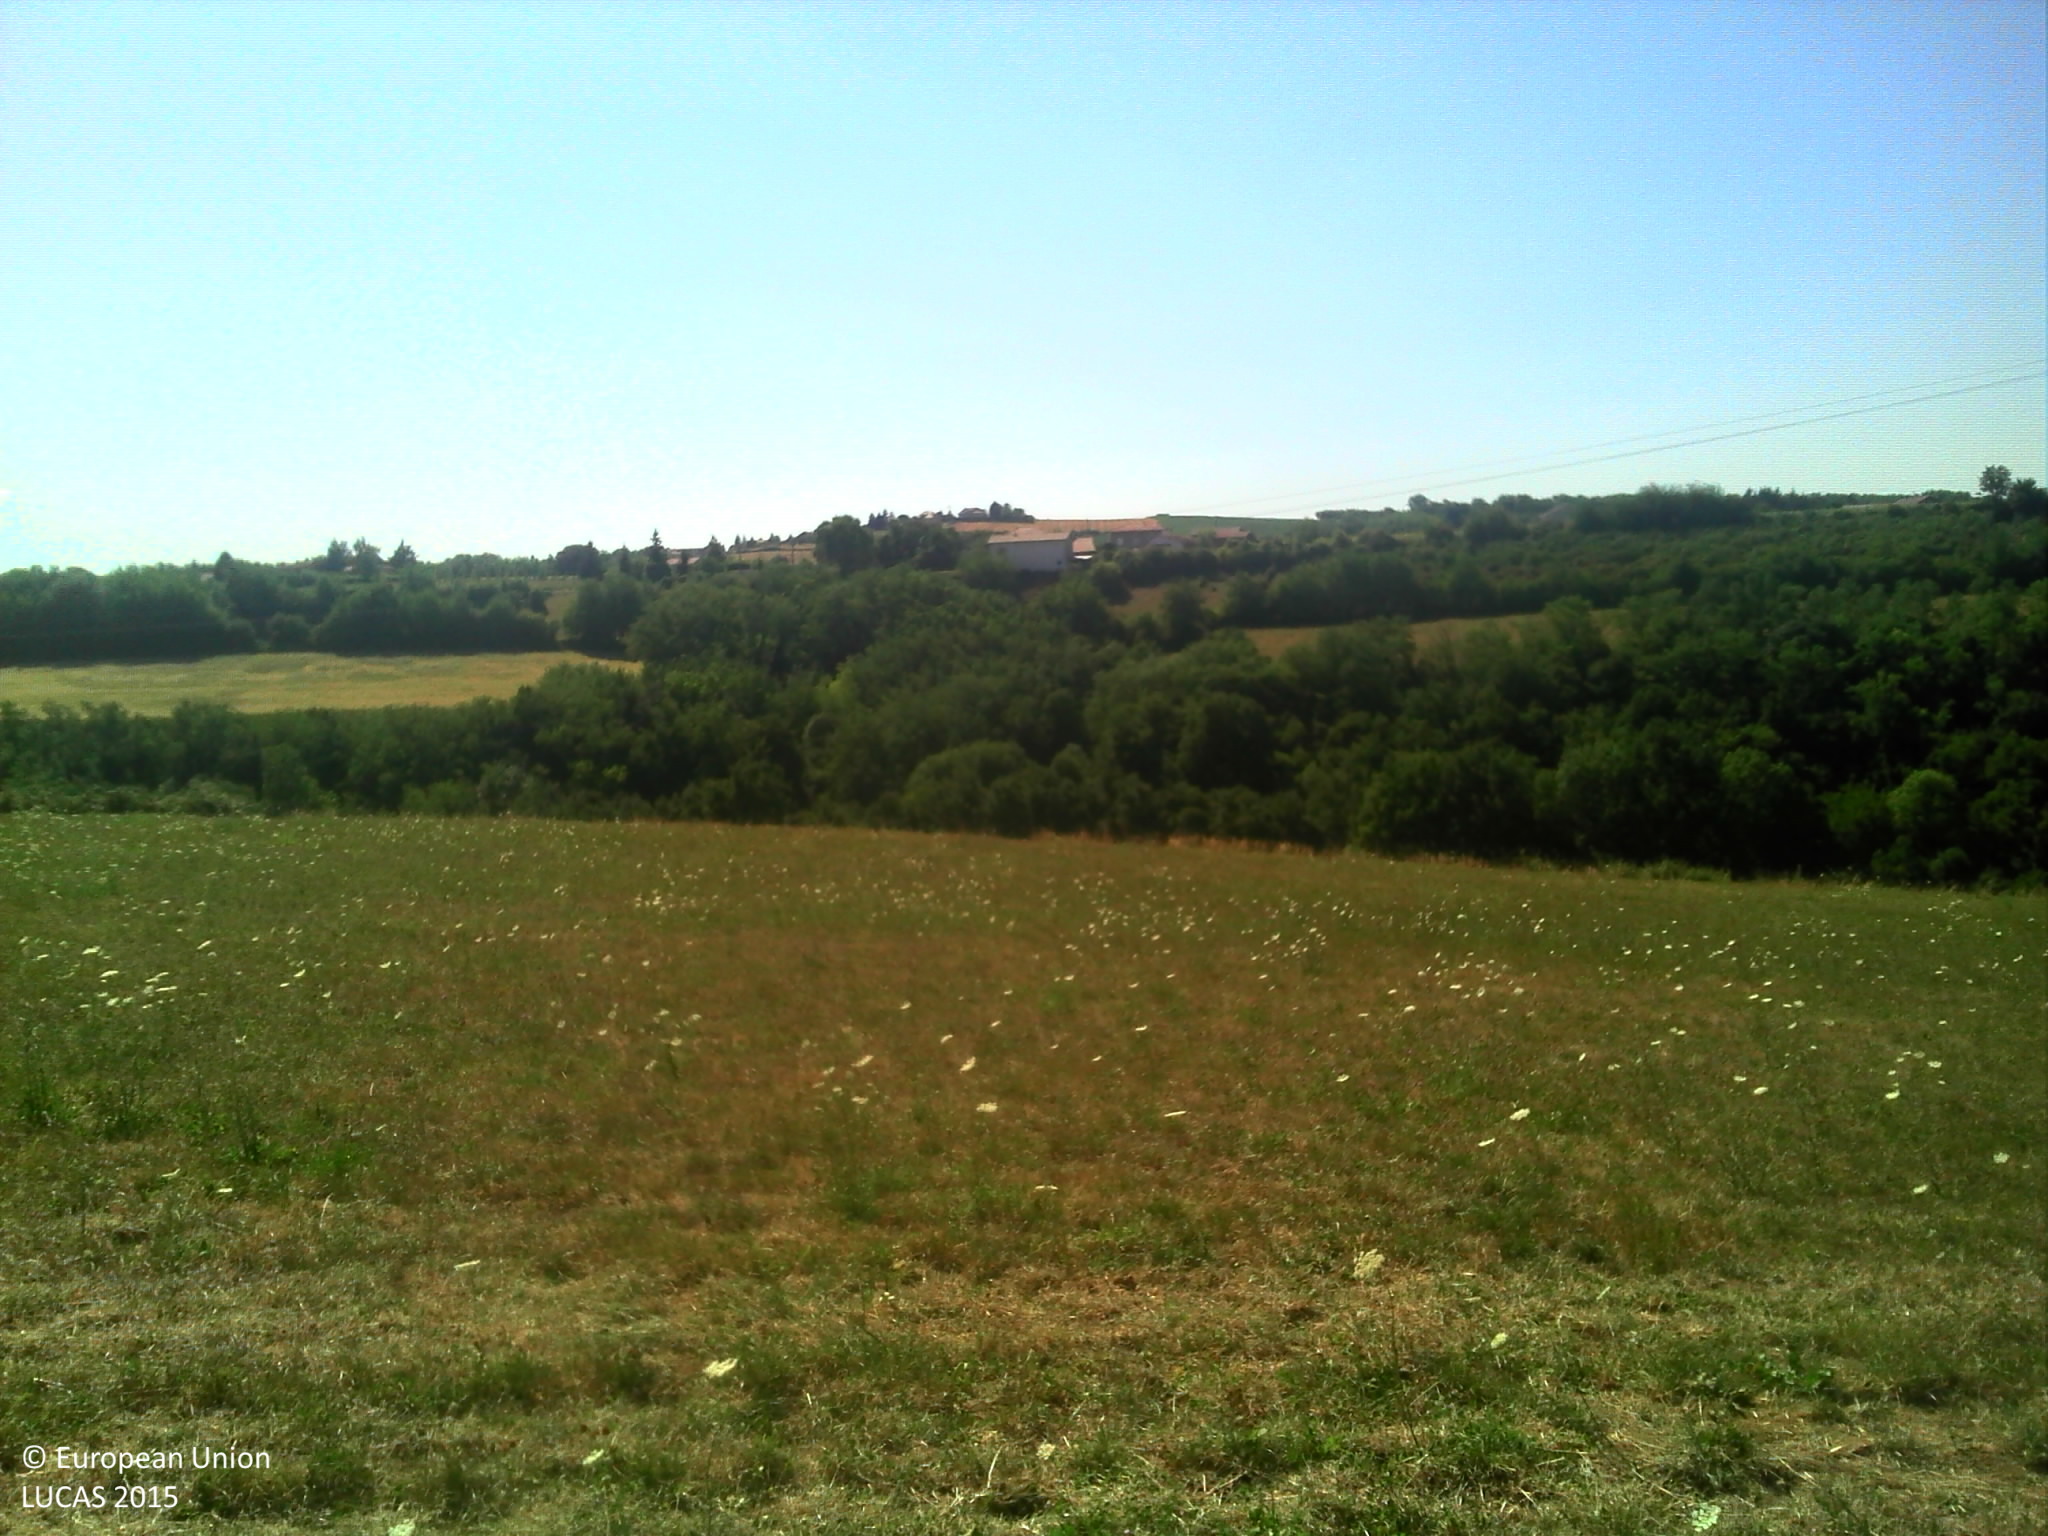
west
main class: Grassland
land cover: Grassland without tree/shrub cover
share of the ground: > 75 %
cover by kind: herbaceous plants 100 %
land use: Agriculture (excluding fallow land and kitchen gardens)
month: July
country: FR
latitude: 45.6010
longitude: 4.9656
